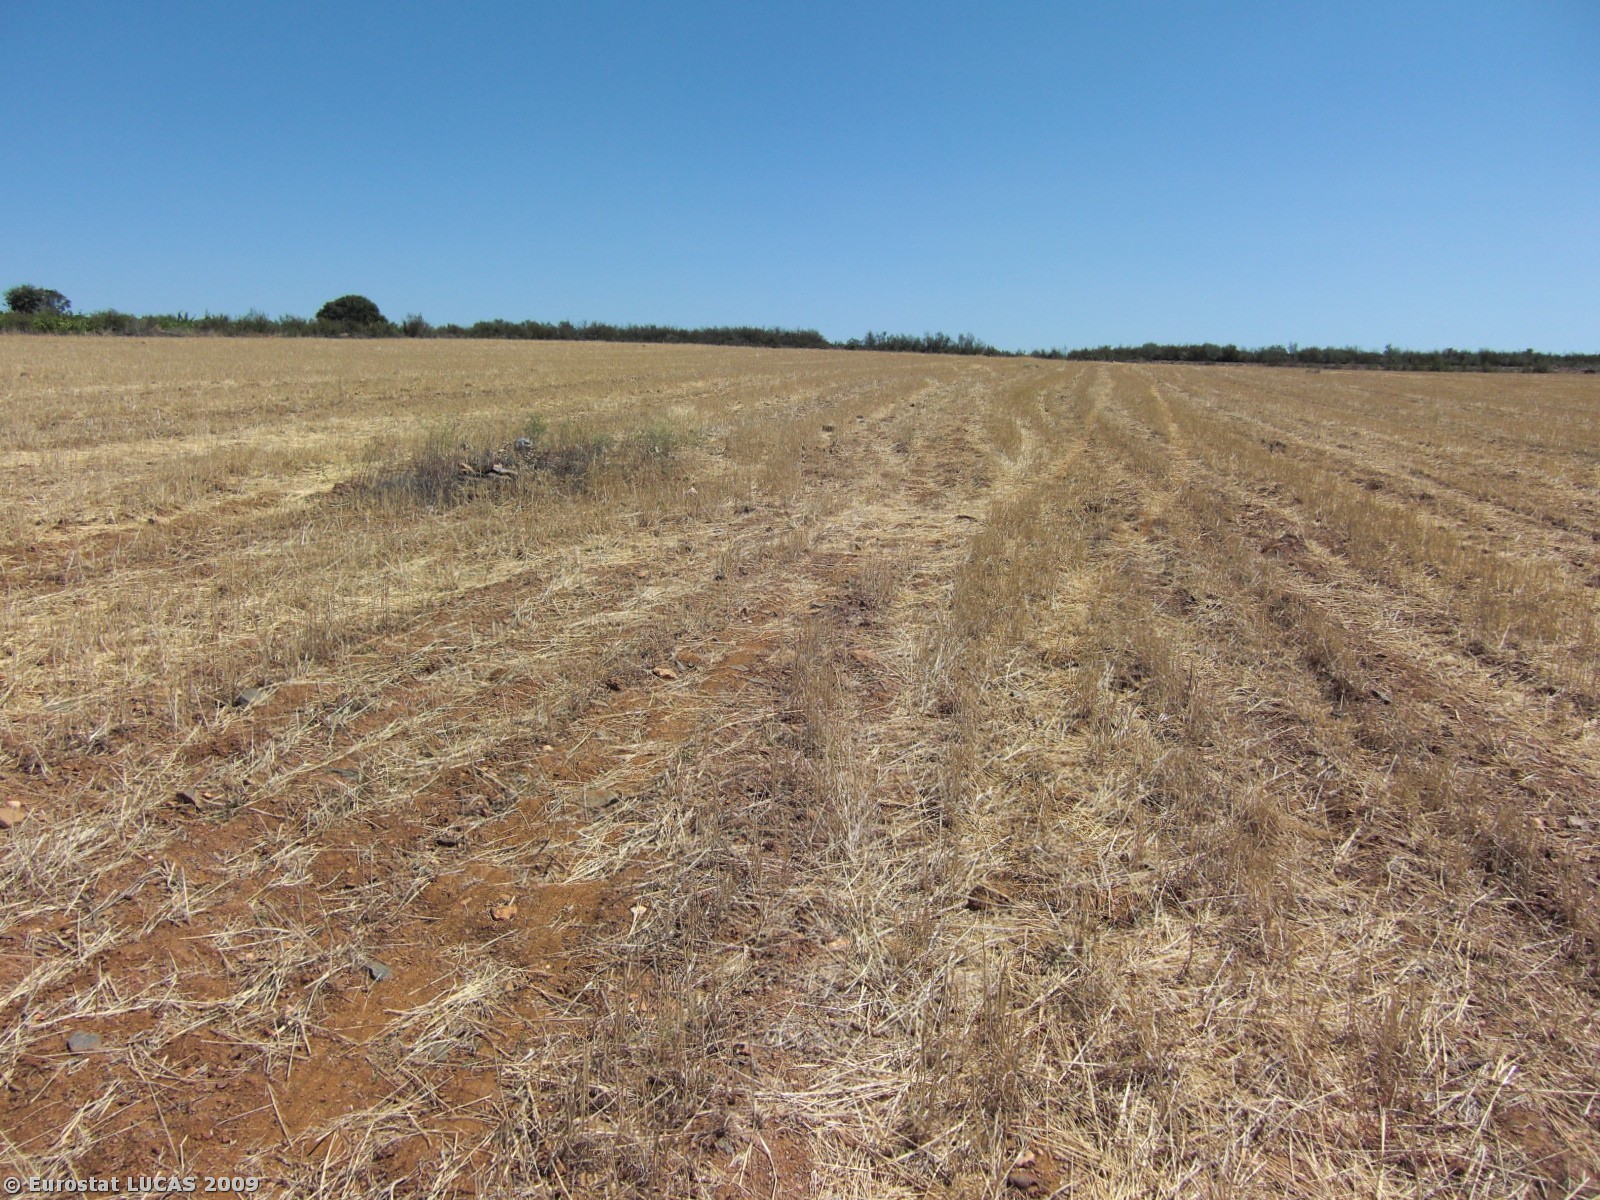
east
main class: Cropland
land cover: Mixed cereals for fodder
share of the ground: < 10 %
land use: Agriculture (excluding fallow land and kitchen gardens)
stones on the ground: > 50 %
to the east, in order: Mixed cereals for fodder; Shrubland without tree cover; Tracks; Spontaneously vegetated surfaces; Bare land; Ditches and canals; Paved roads, cycling and walking lanes; Shrubland without tree cover; Olive groves; Shrubland without tree cover; Tracks
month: August
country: PT
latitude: 41.4433
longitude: -6.4627
